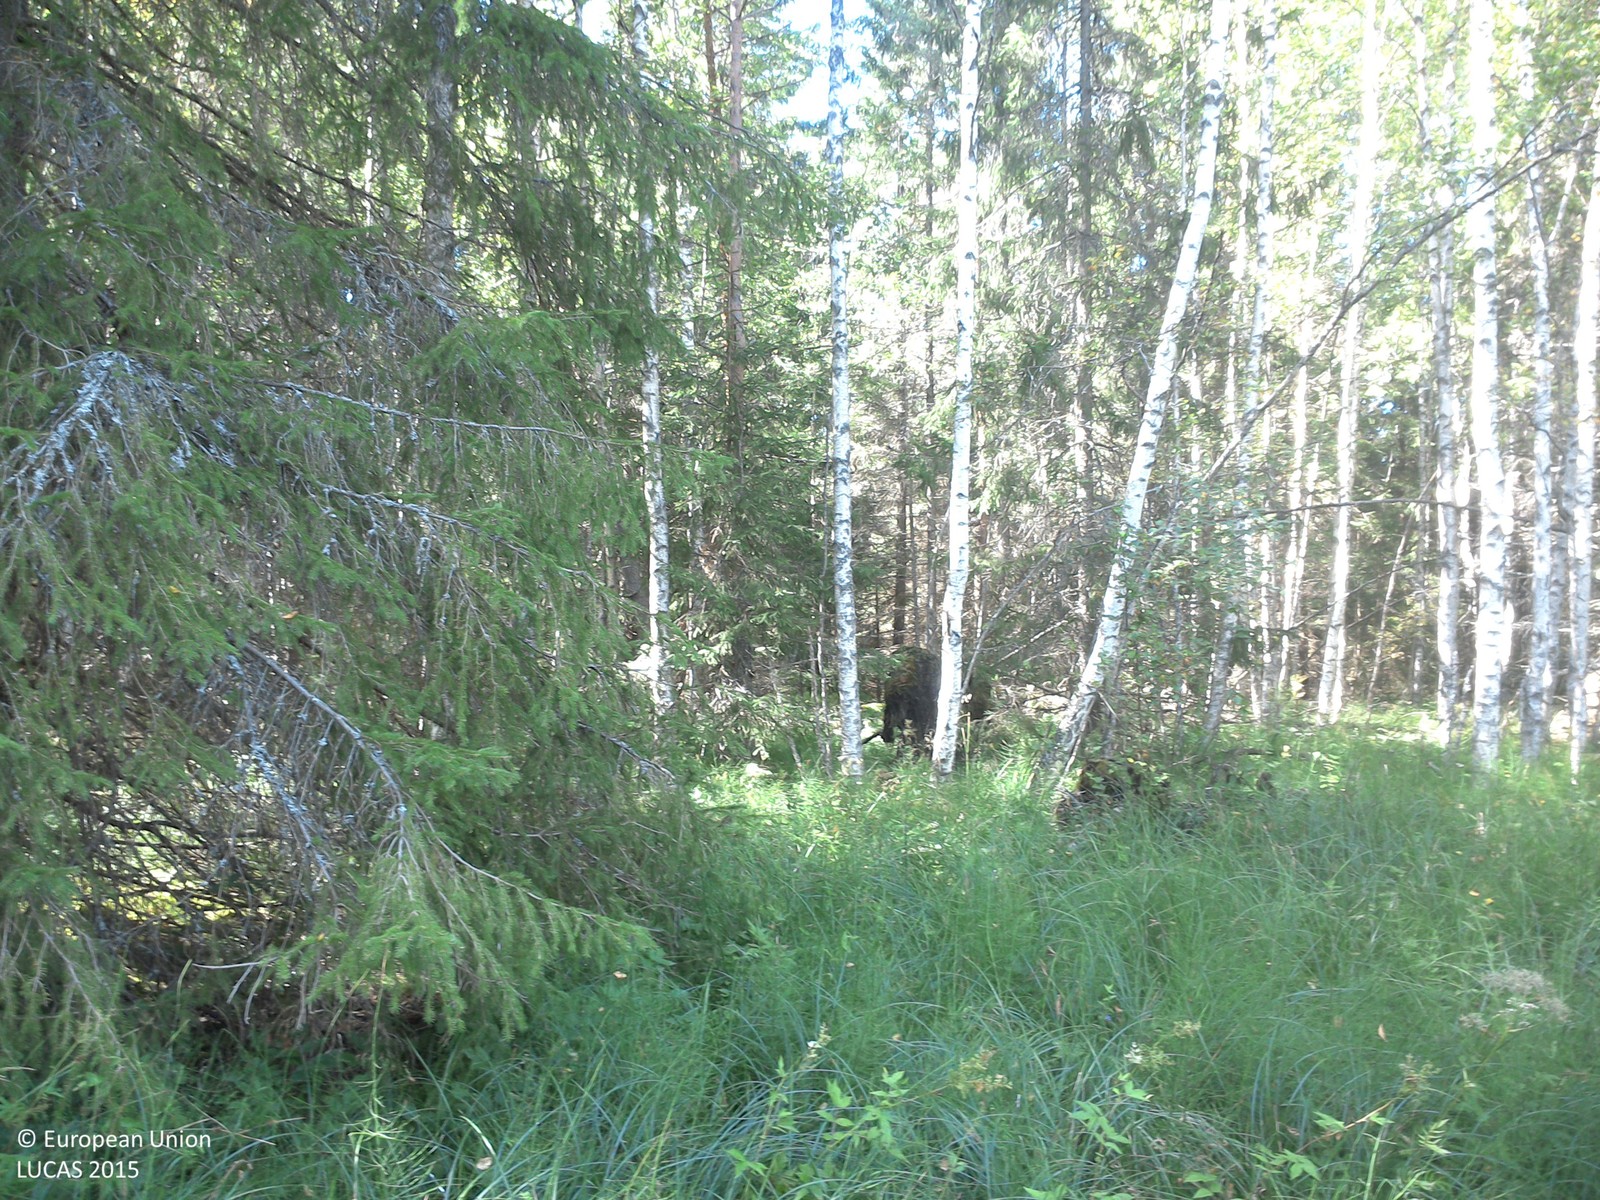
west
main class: Woodland
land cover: Broadleaved woodland
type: mire and swamp forests
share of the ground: 25 - 50 %
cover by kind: herbaceous plants 70 %, broadleaved forest trees 30 %
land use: Forestry
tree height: > 5 m
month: August
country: SE
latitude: 57.9108
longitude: 15.4471
